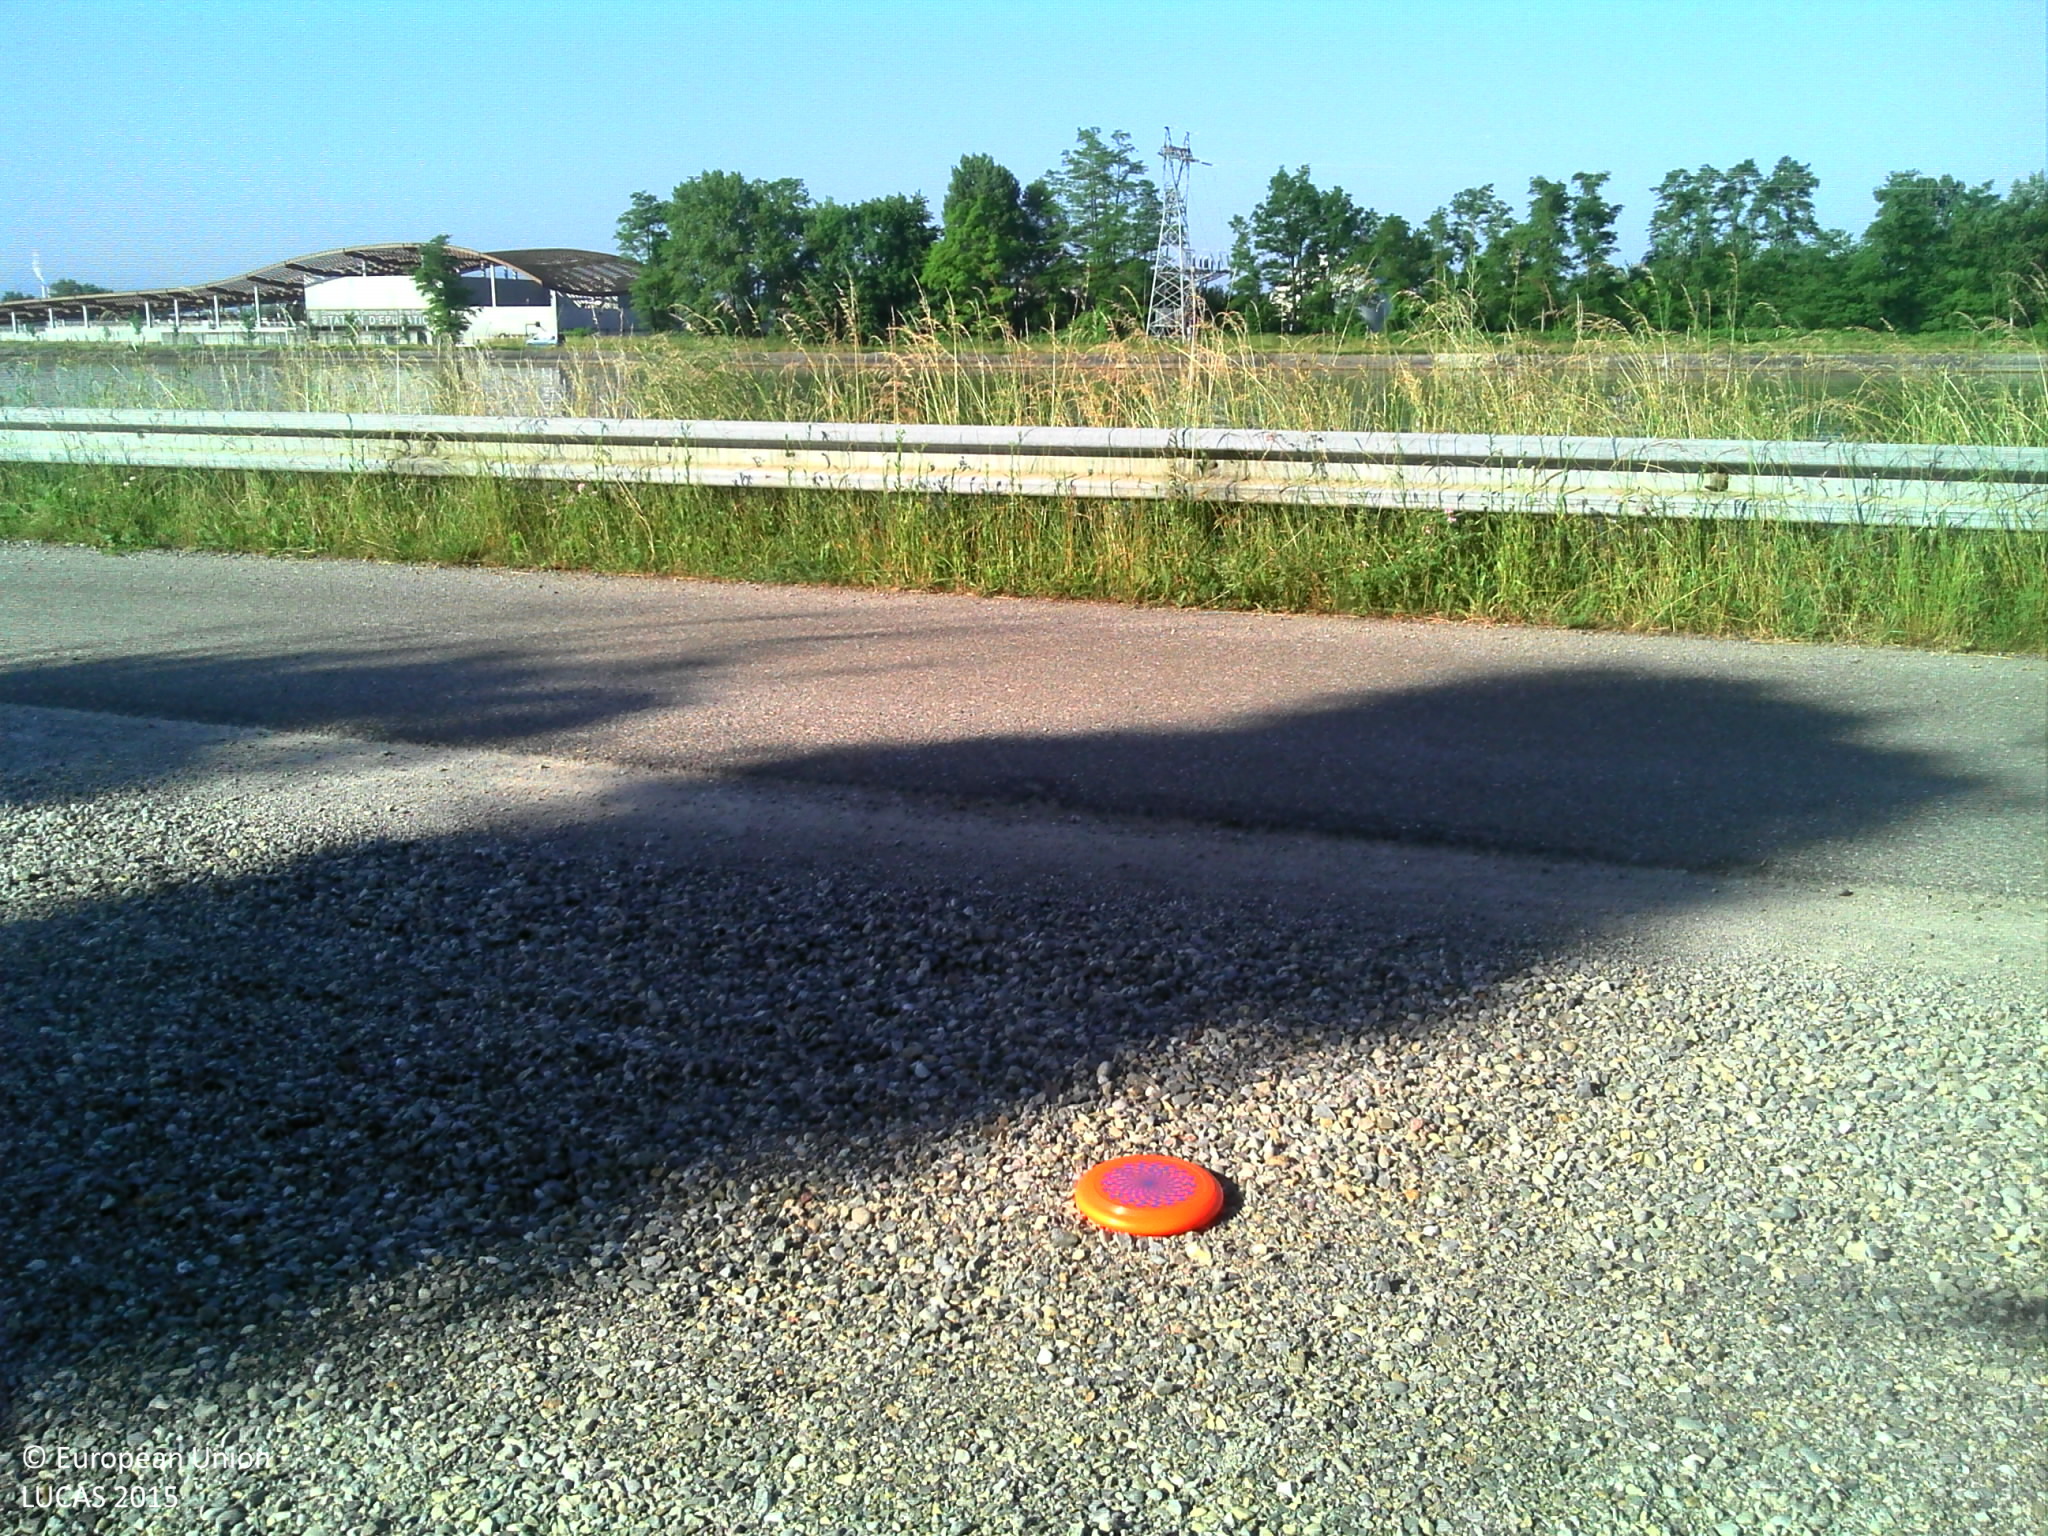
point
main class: Grassland
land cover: Grassland without tree/shrub cover
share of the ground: > 75 %
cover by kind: herbaceous plants 100 %
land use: Road transport
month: June
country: FR
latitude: 47.6205
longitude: 7.5666
